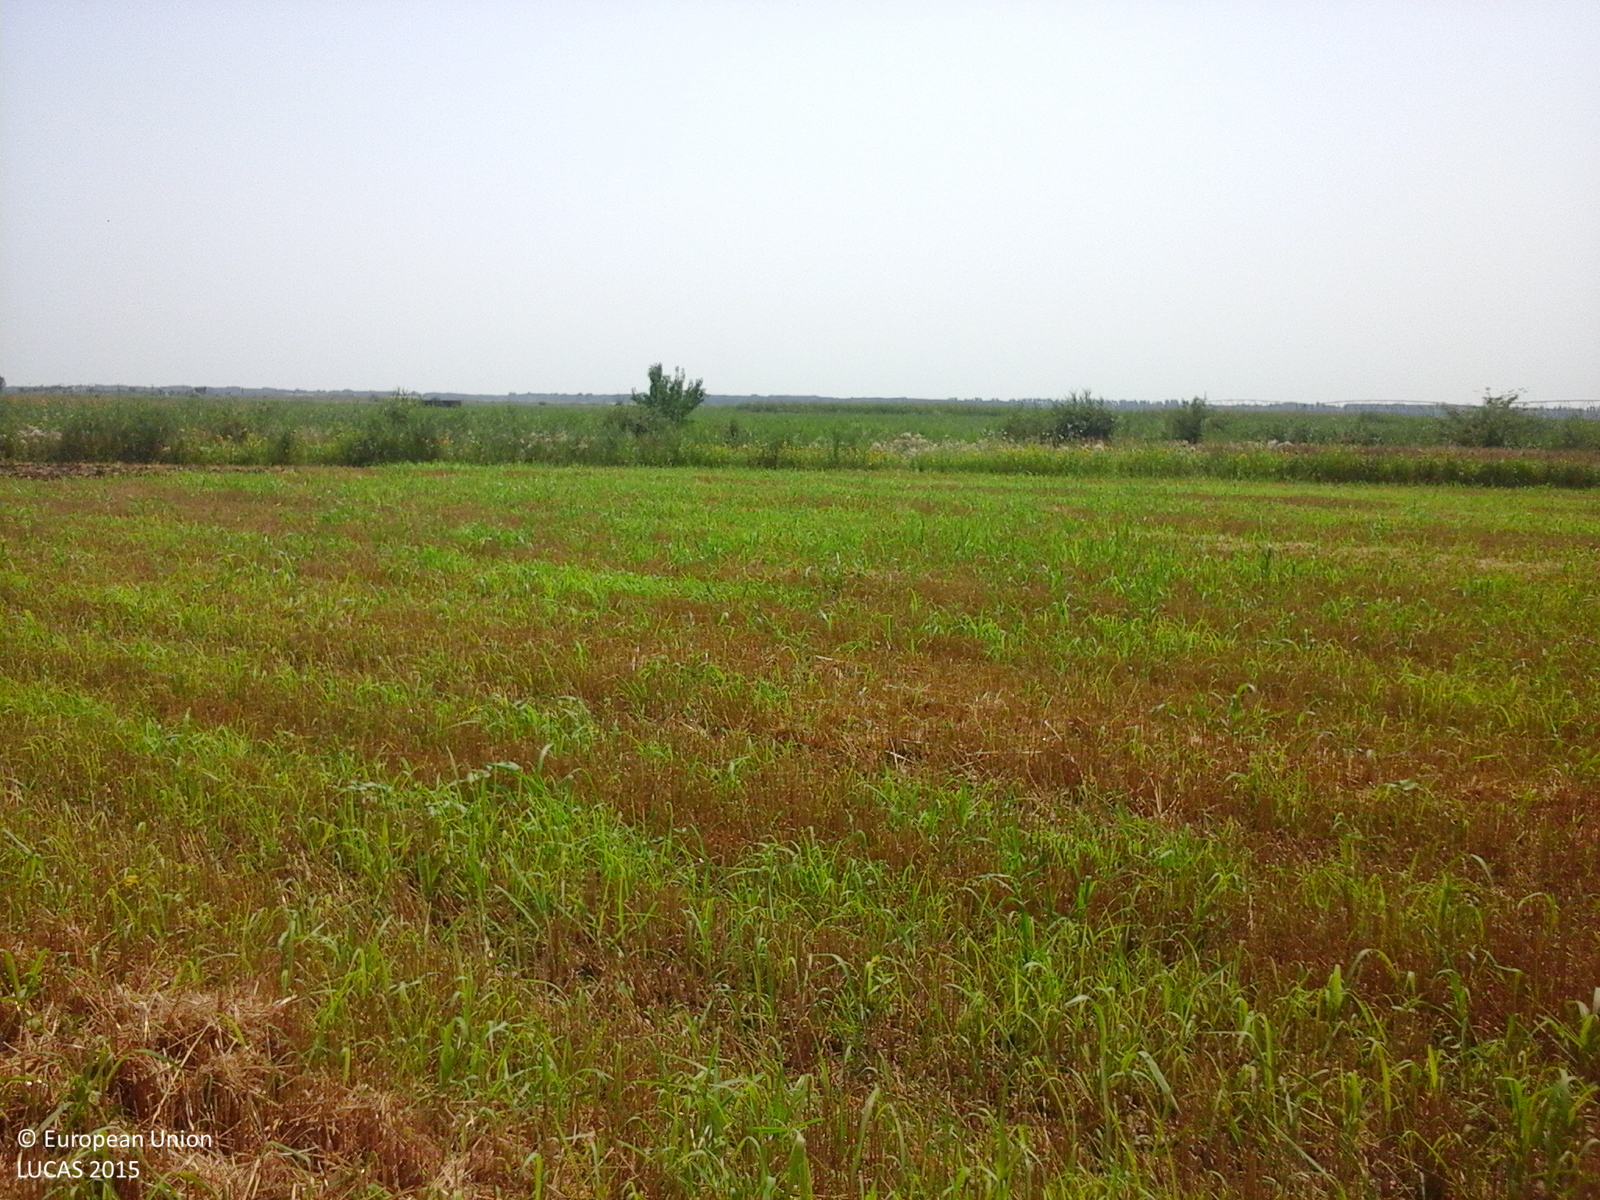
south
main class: Cropland
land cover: Common wheat
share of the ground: 25 - 50 %
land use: Agriculture (excluding fallow land and kitchen gardens)
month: July
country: RO
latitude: 44.7343
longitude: 26.5738
